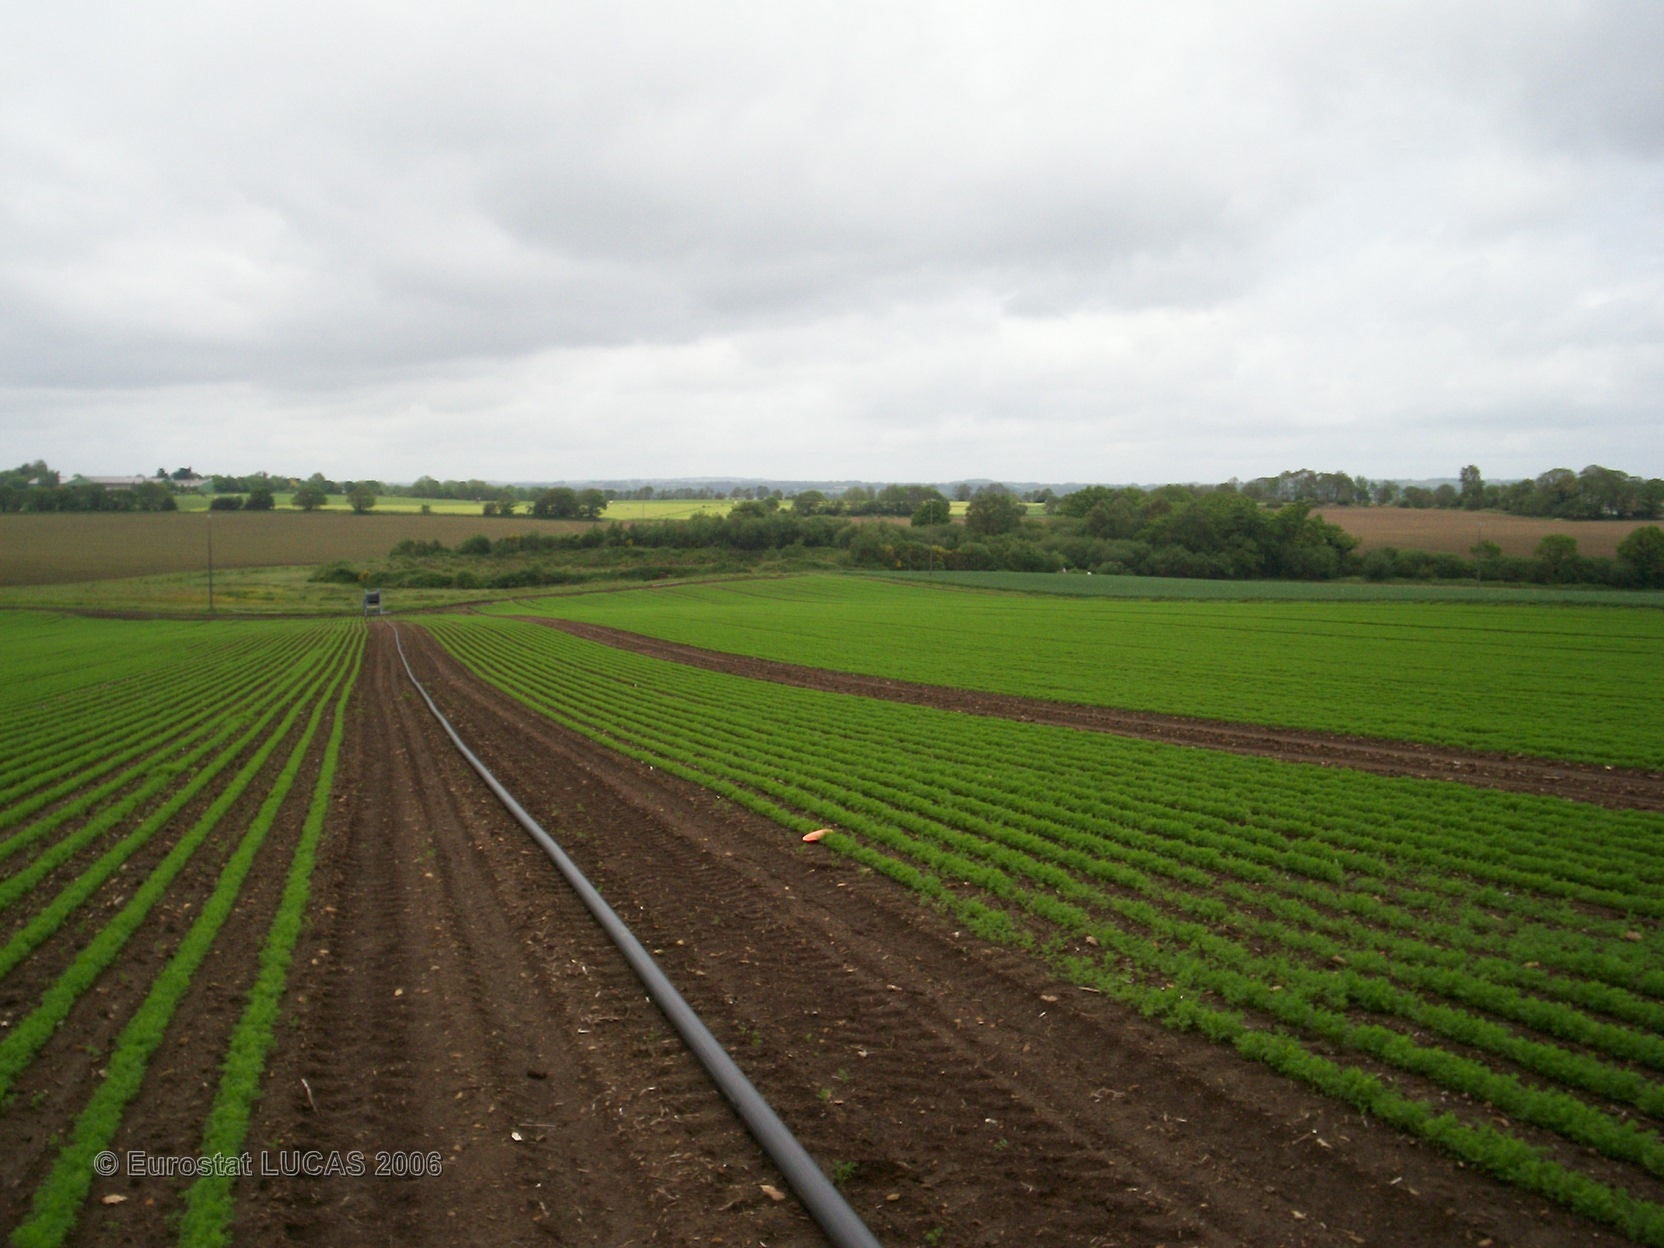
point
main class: Cropland
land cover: Other fresh vegetables
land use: Agriculture (excluding fallow land and kitchen gardens)
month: May
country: FR
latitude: 47.9079
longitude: -3.5768
